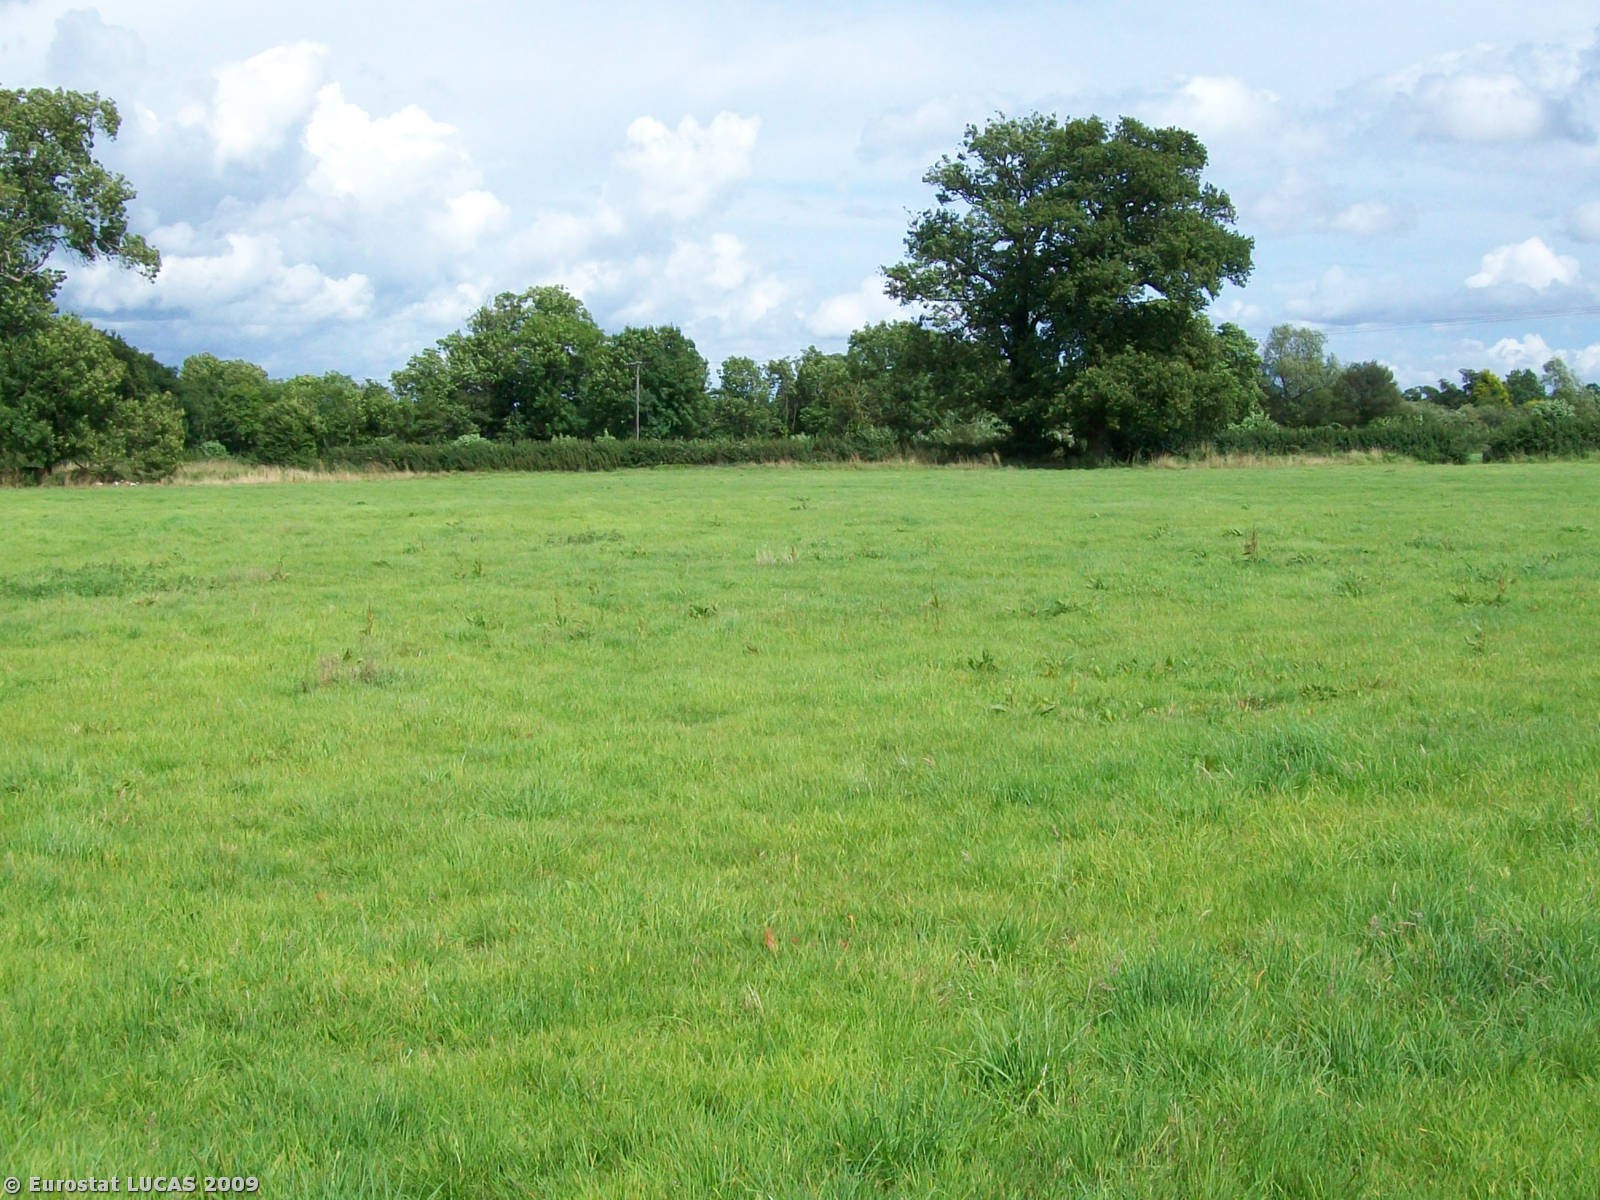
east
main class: Grassland
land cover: Grassland without tree/shrub cover
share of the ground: > 75 %
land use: Agriculture (excluding fallow land and kitchen gardens)
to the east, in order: Grassland without tree/shrub cover; Managed hedges; Grassland without tree/shrub cover; Managed hedges; Grass margins; Paved roads, cycling and walking lanes; Broadleaved woodland; Grassland without tree/shrub cover
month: July
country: GB
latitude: 51.5020
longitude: -2.2646
